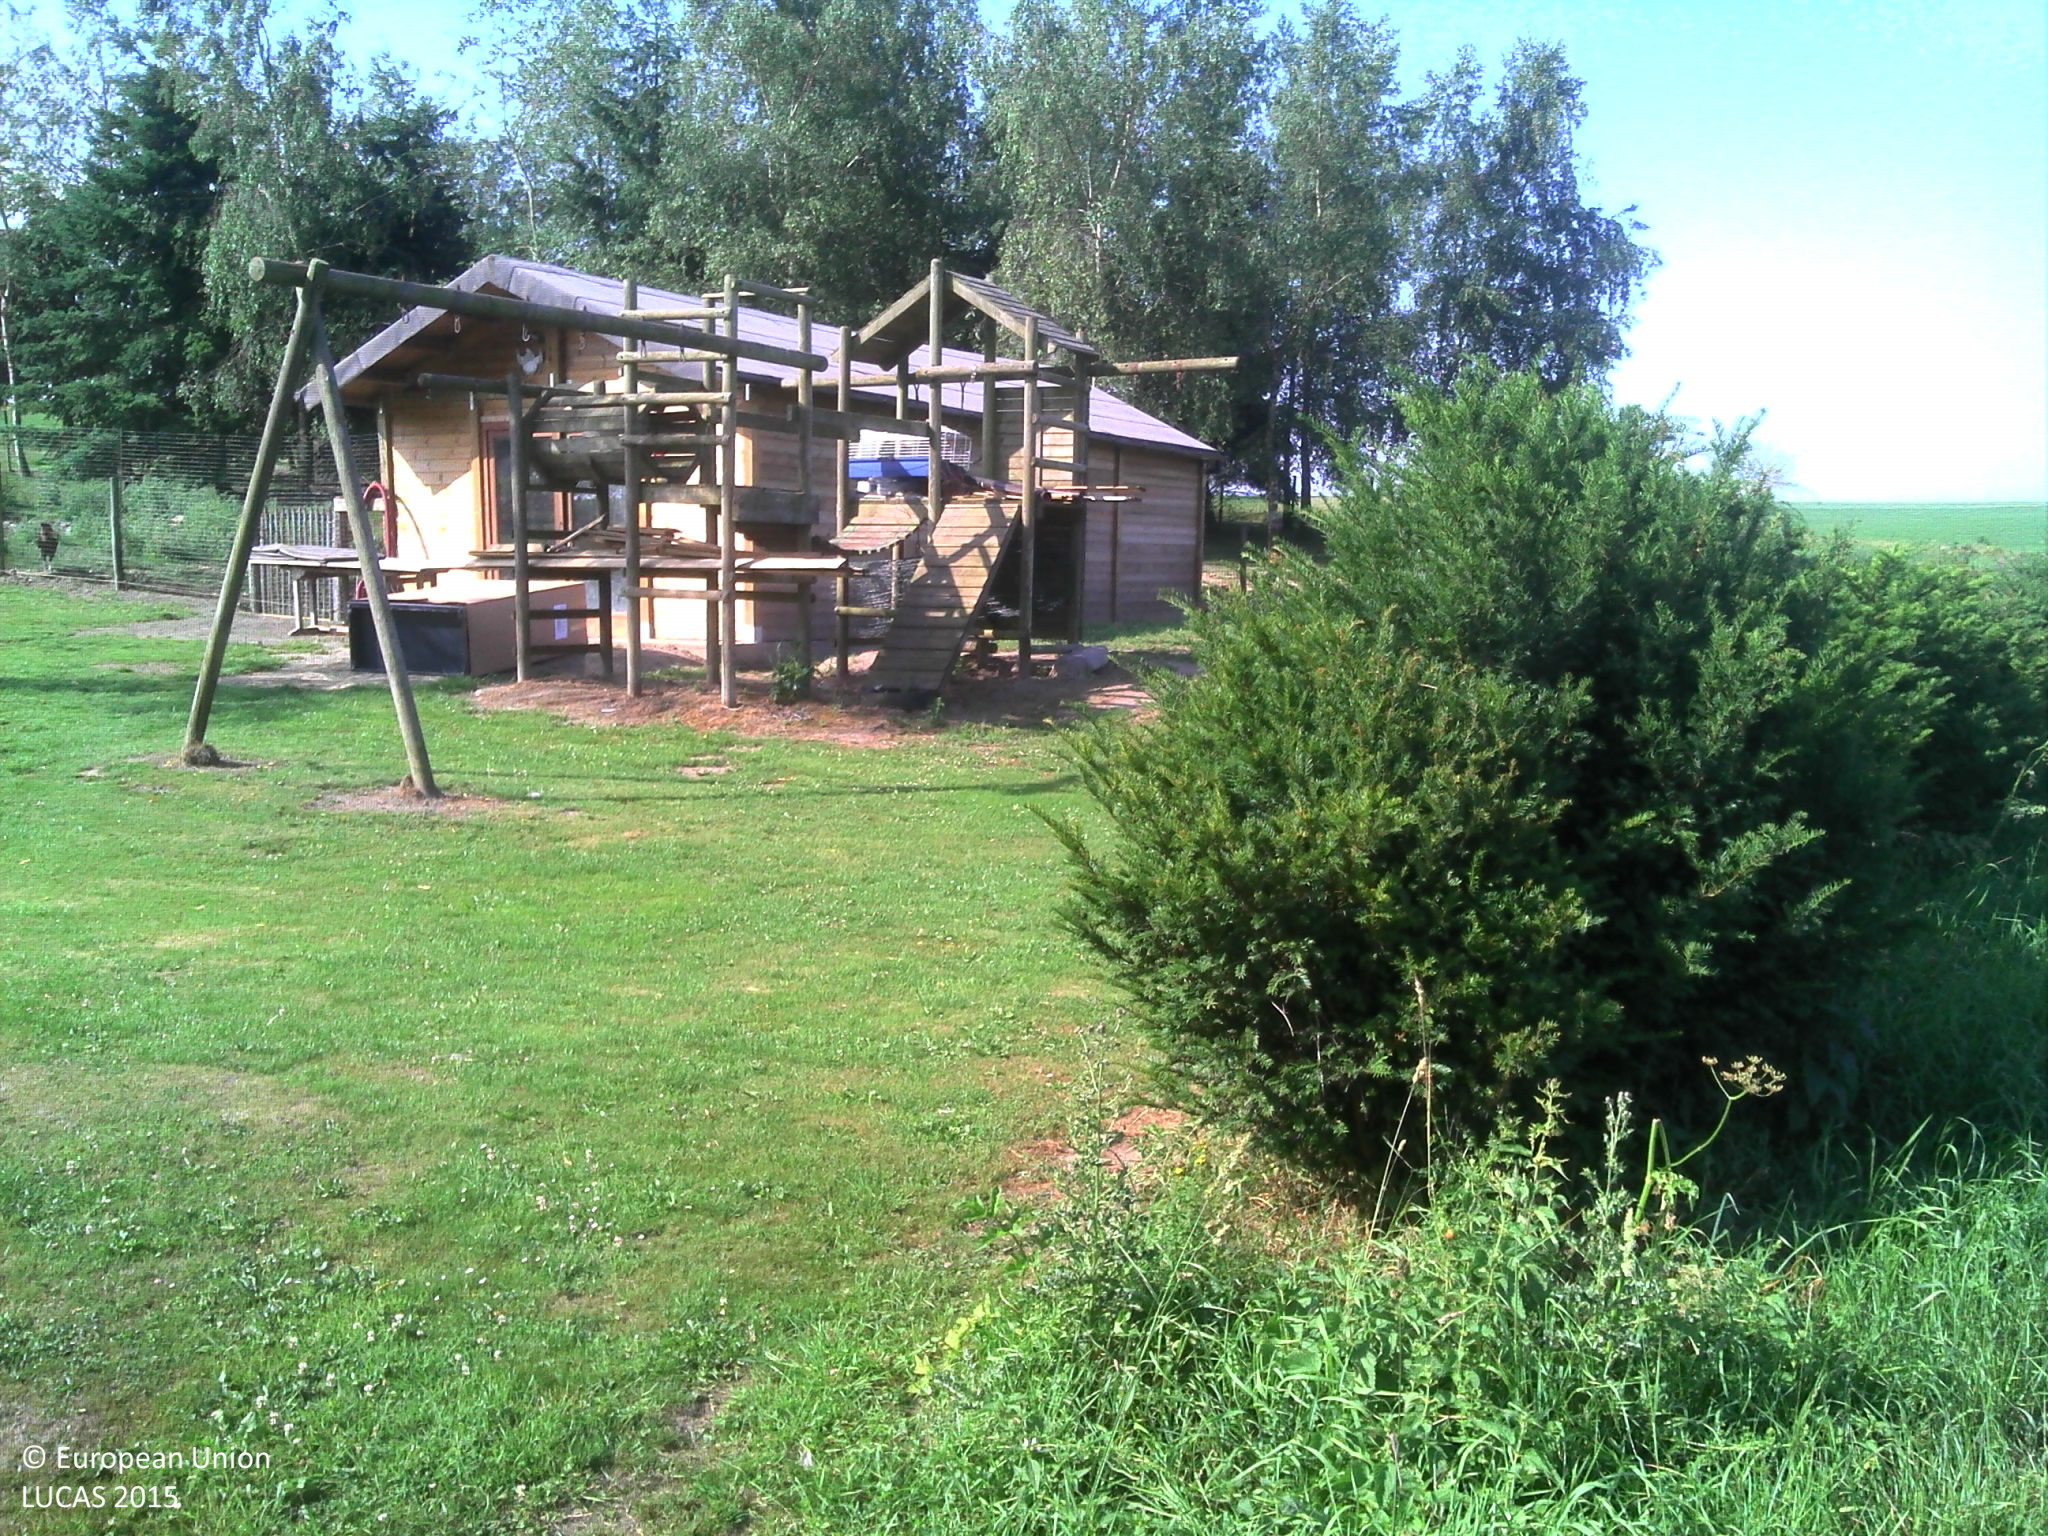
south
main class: Grassland
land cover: Grassland without tree/shrub cover
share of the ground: > 75 %
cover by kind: herbaceous plants 100 %
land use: Residential
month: July
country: BE
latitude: 49.9735
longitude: 5.6063
